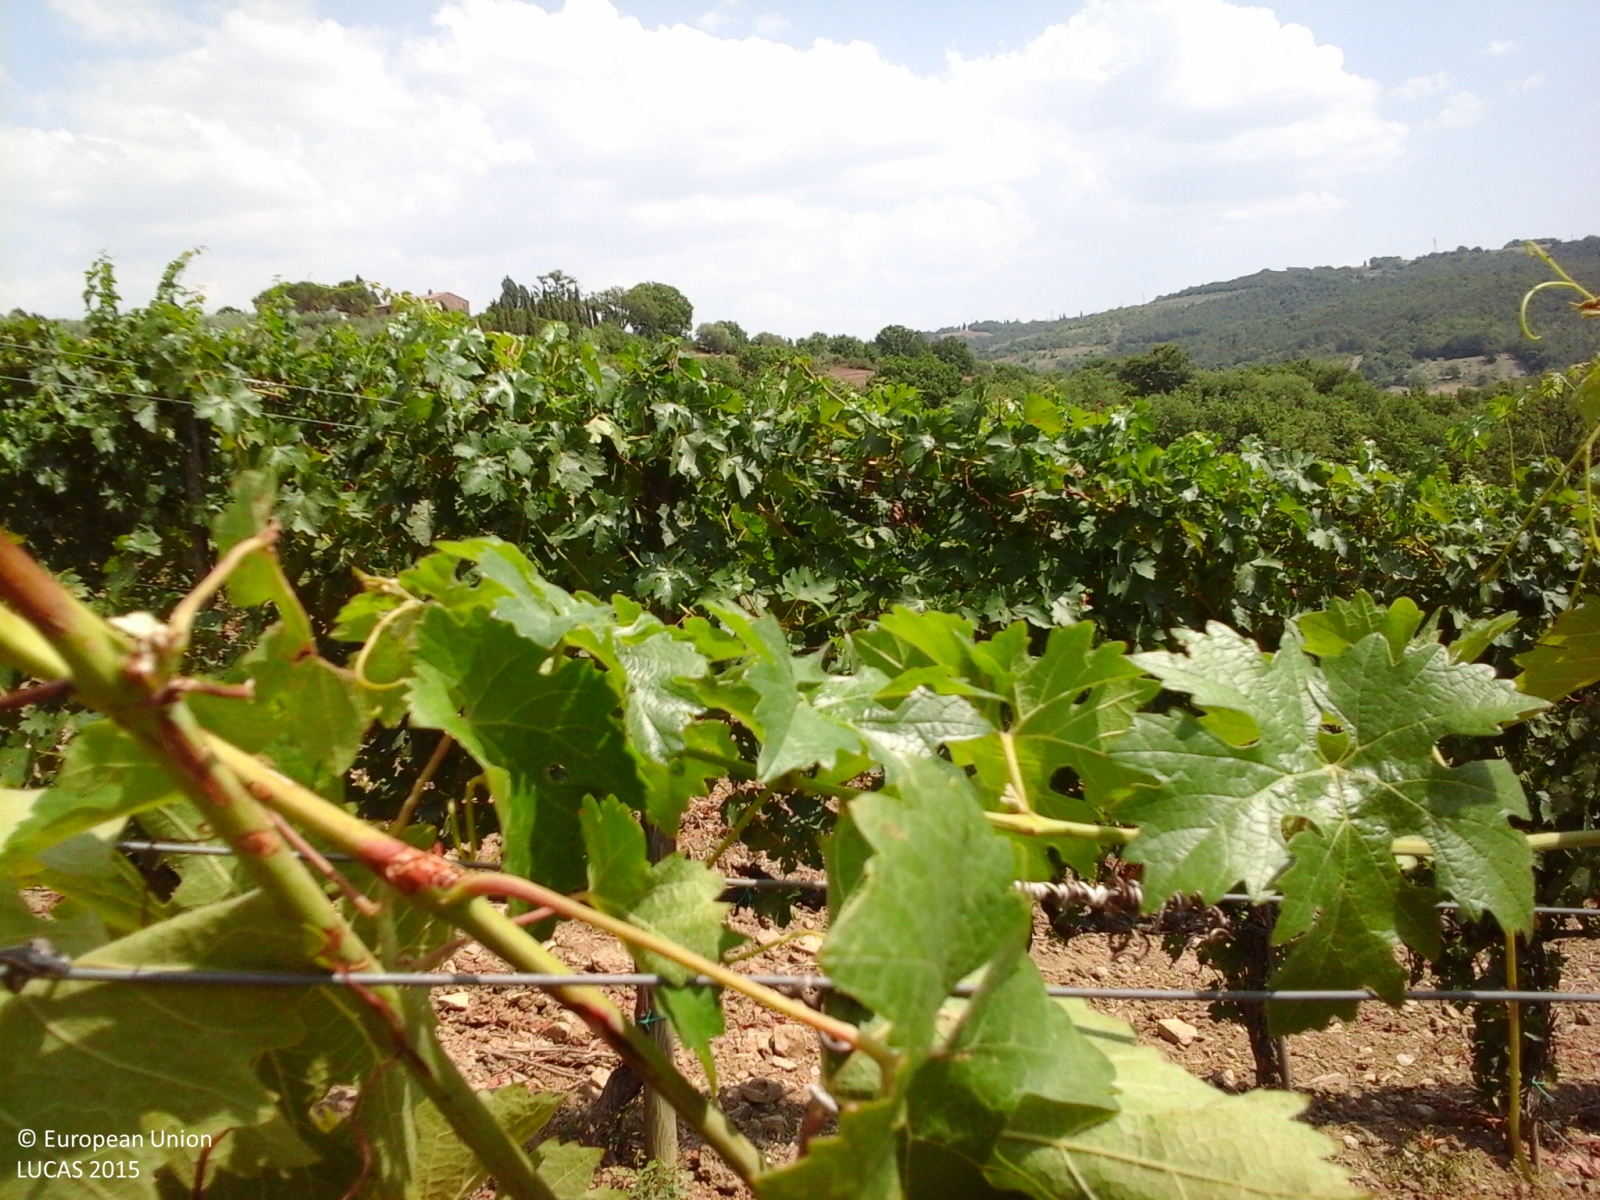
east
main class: Woodland
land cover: Broadleaved woodland
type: thermophilous deciduous forest
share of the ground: > 75 %
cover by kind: broadleaved forest trees 75 %, shrubs 20 %, herbaceous plants 5 %
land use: Forestry
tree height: > 5 m
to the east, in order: Broadleaved woodland; Fences; Vineyards; Fences; Grassland without tree/shrub cover; Olive groves; Oats
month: July
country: IT
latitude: 43.0571
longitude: 11.5791
